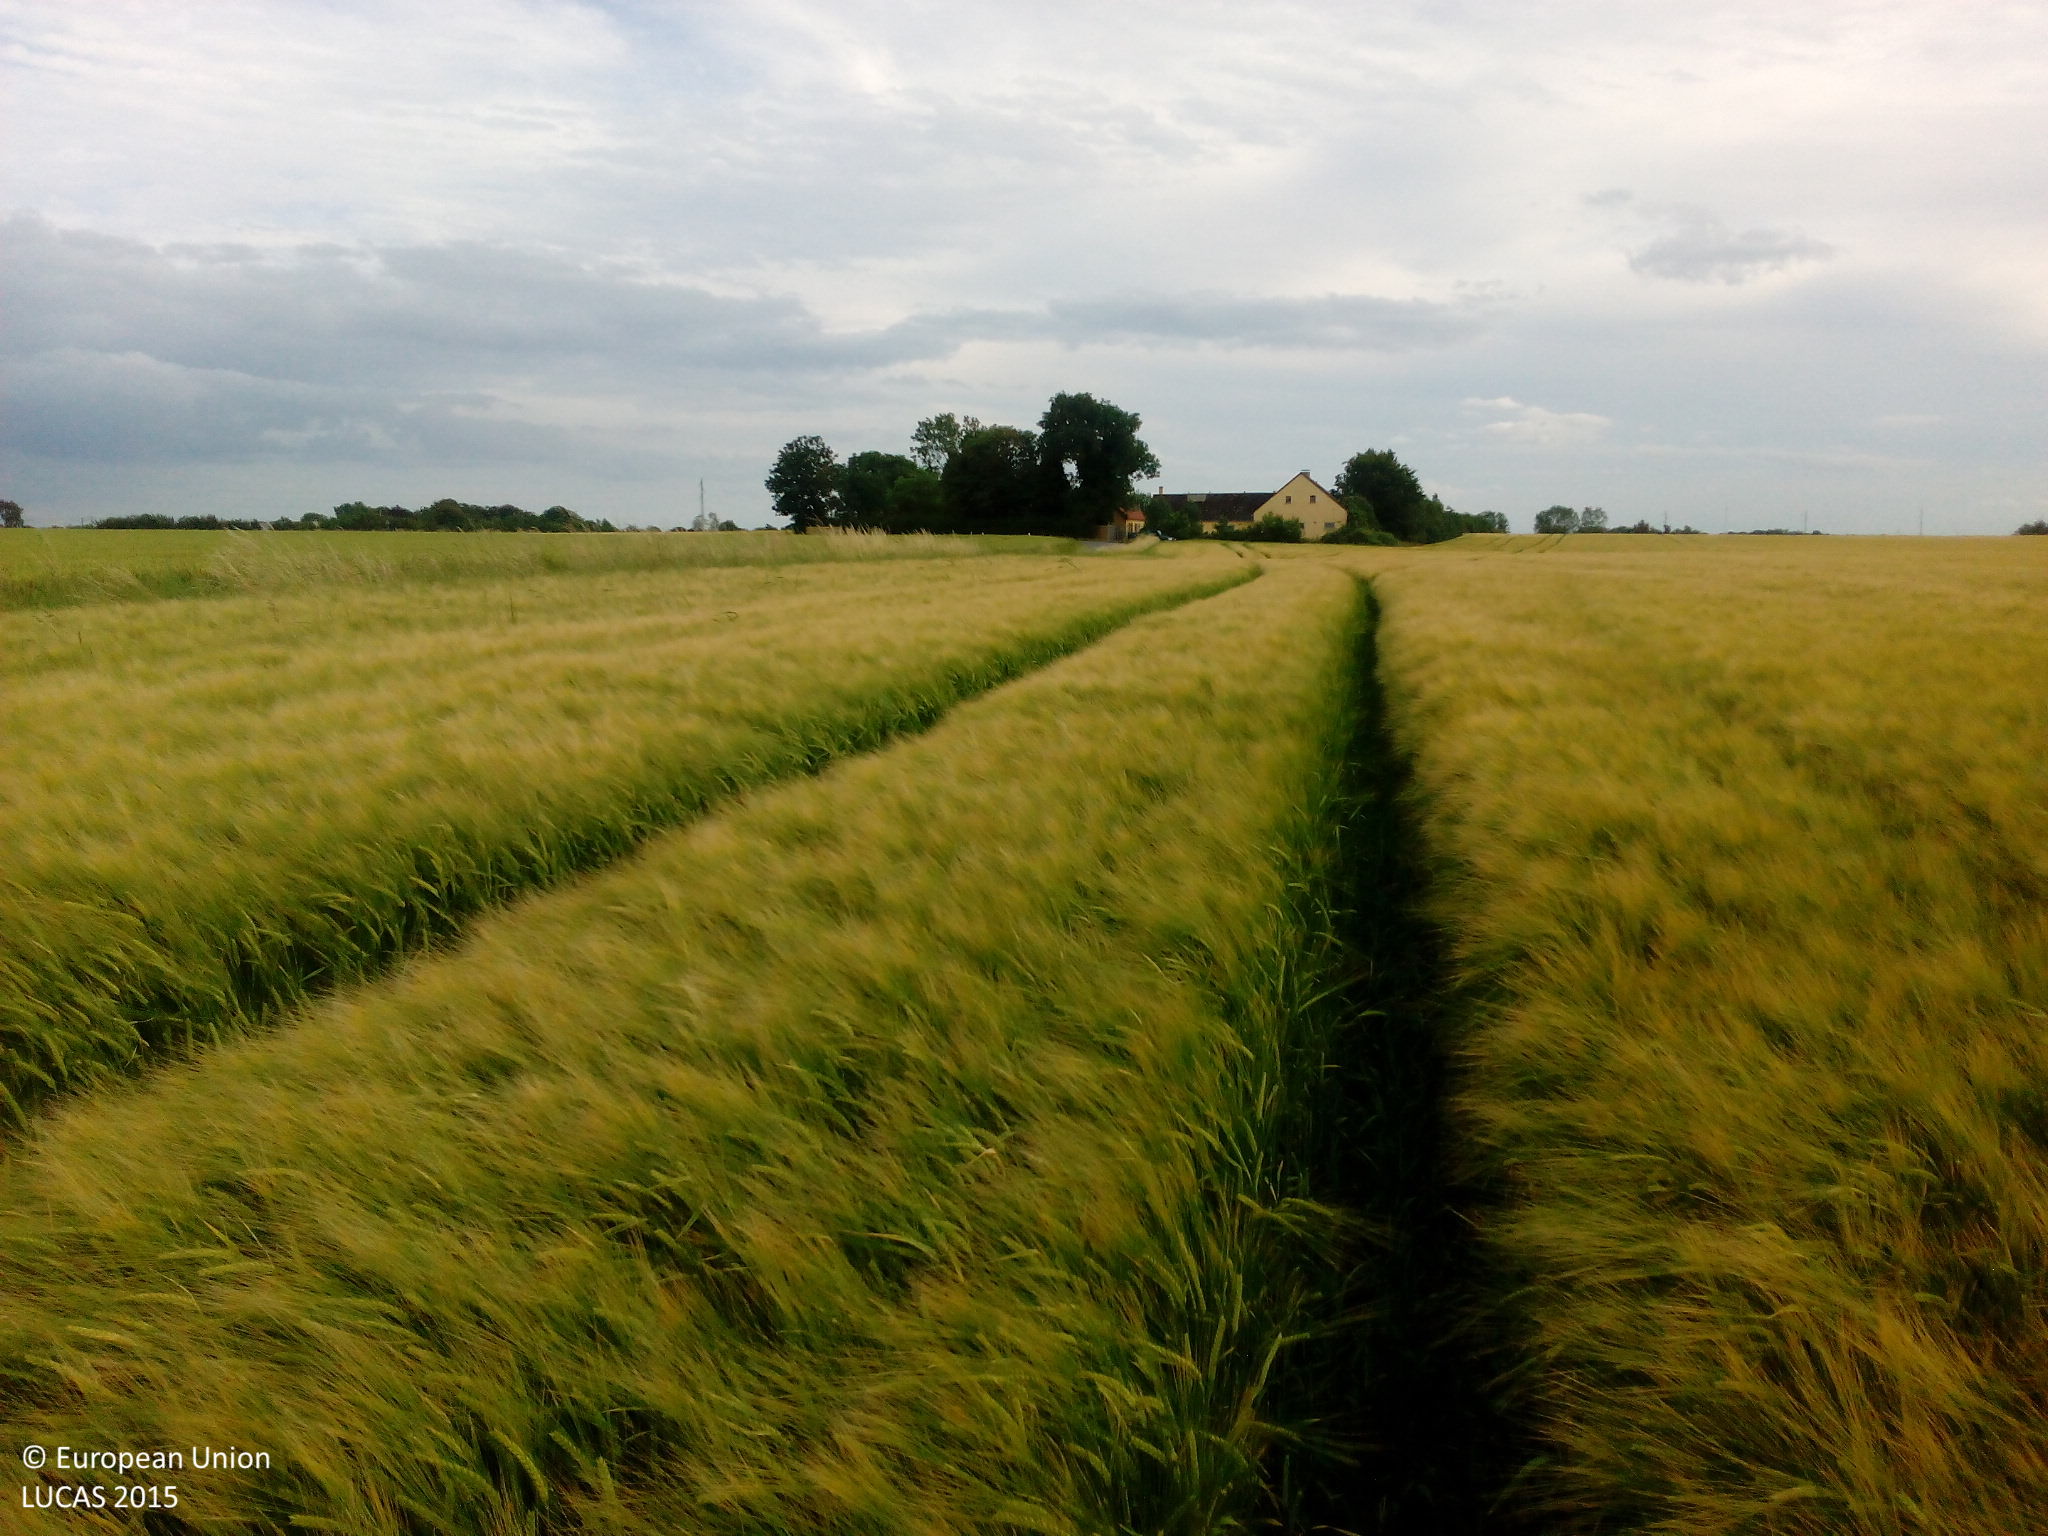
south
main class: Cropland
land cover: Barley
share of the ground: > 75 %
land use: Agriculture (excluding fallow land and kitchen gardens)
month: July
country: DK
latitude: 55.3904
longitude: 11.2776
